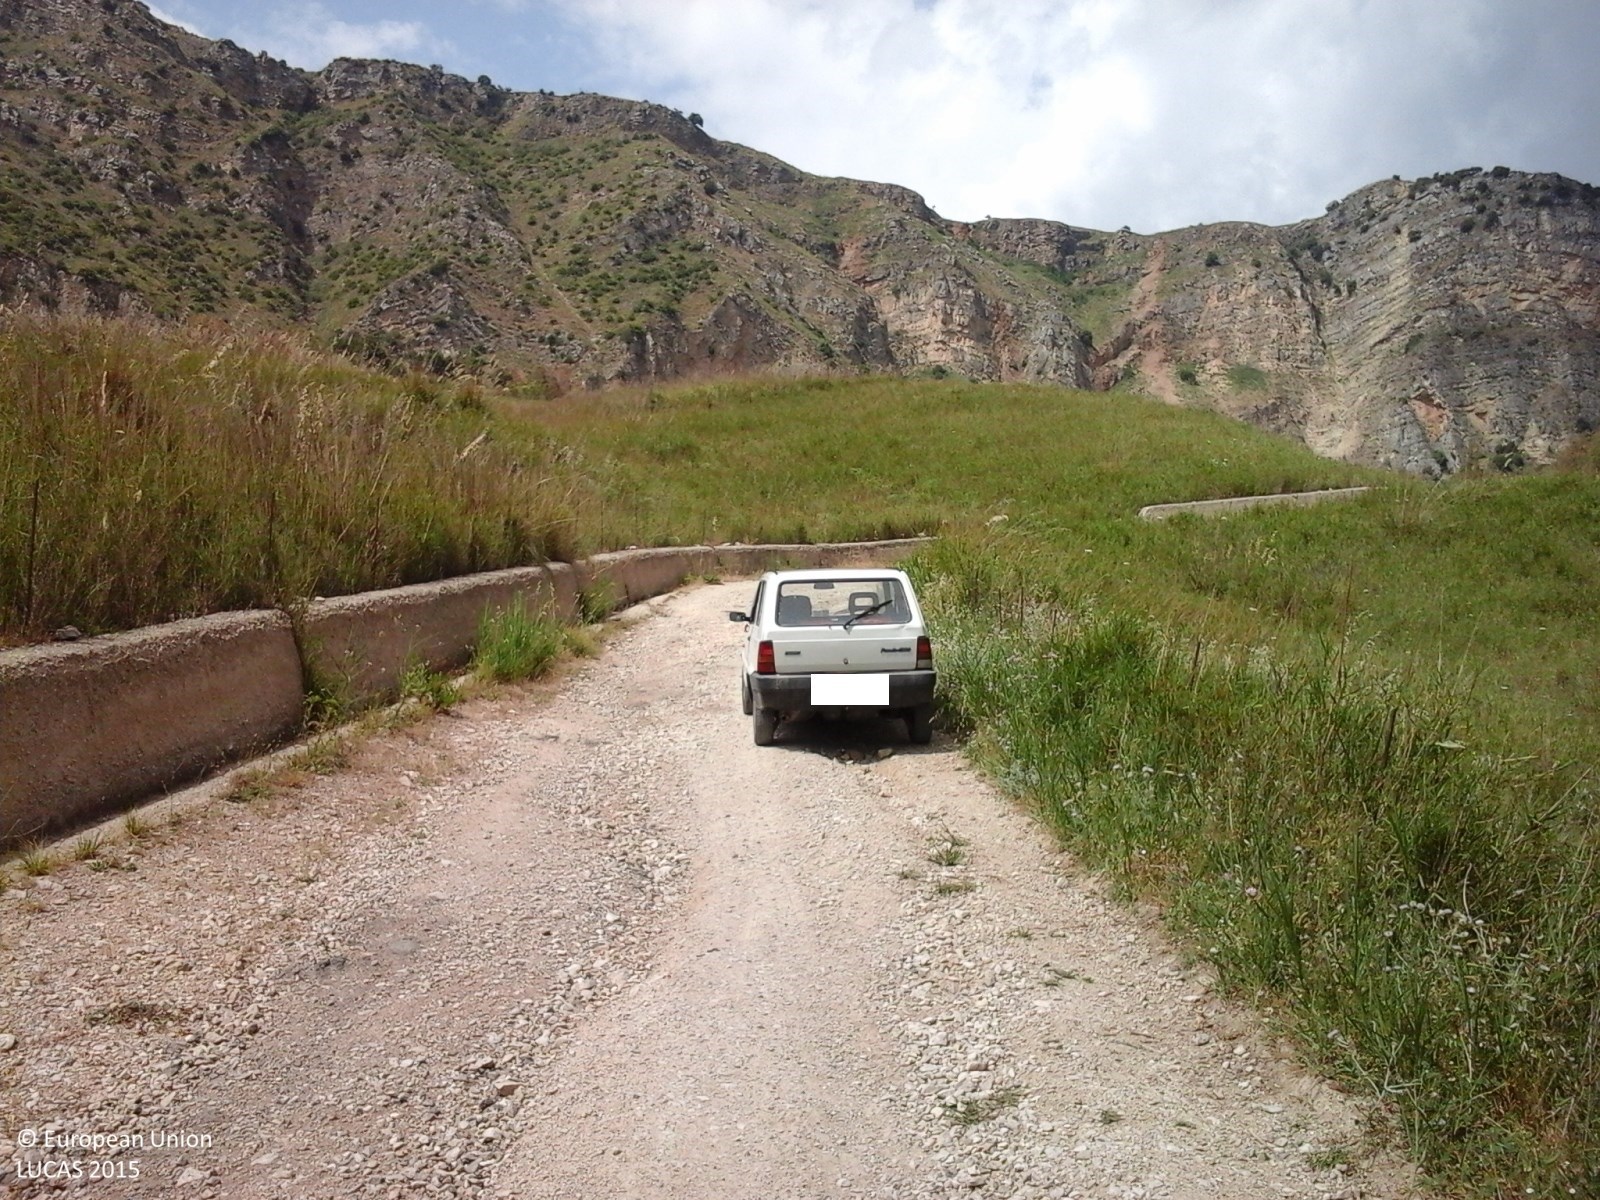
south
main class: Grassland
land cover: Grassland without tree/shrub cover
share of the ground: > 75 %
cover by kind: herbaceous plants 100 %
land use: Semi-natural and natural areas not in use
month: June
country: IT
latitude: 37.5899
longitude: 13.5633
